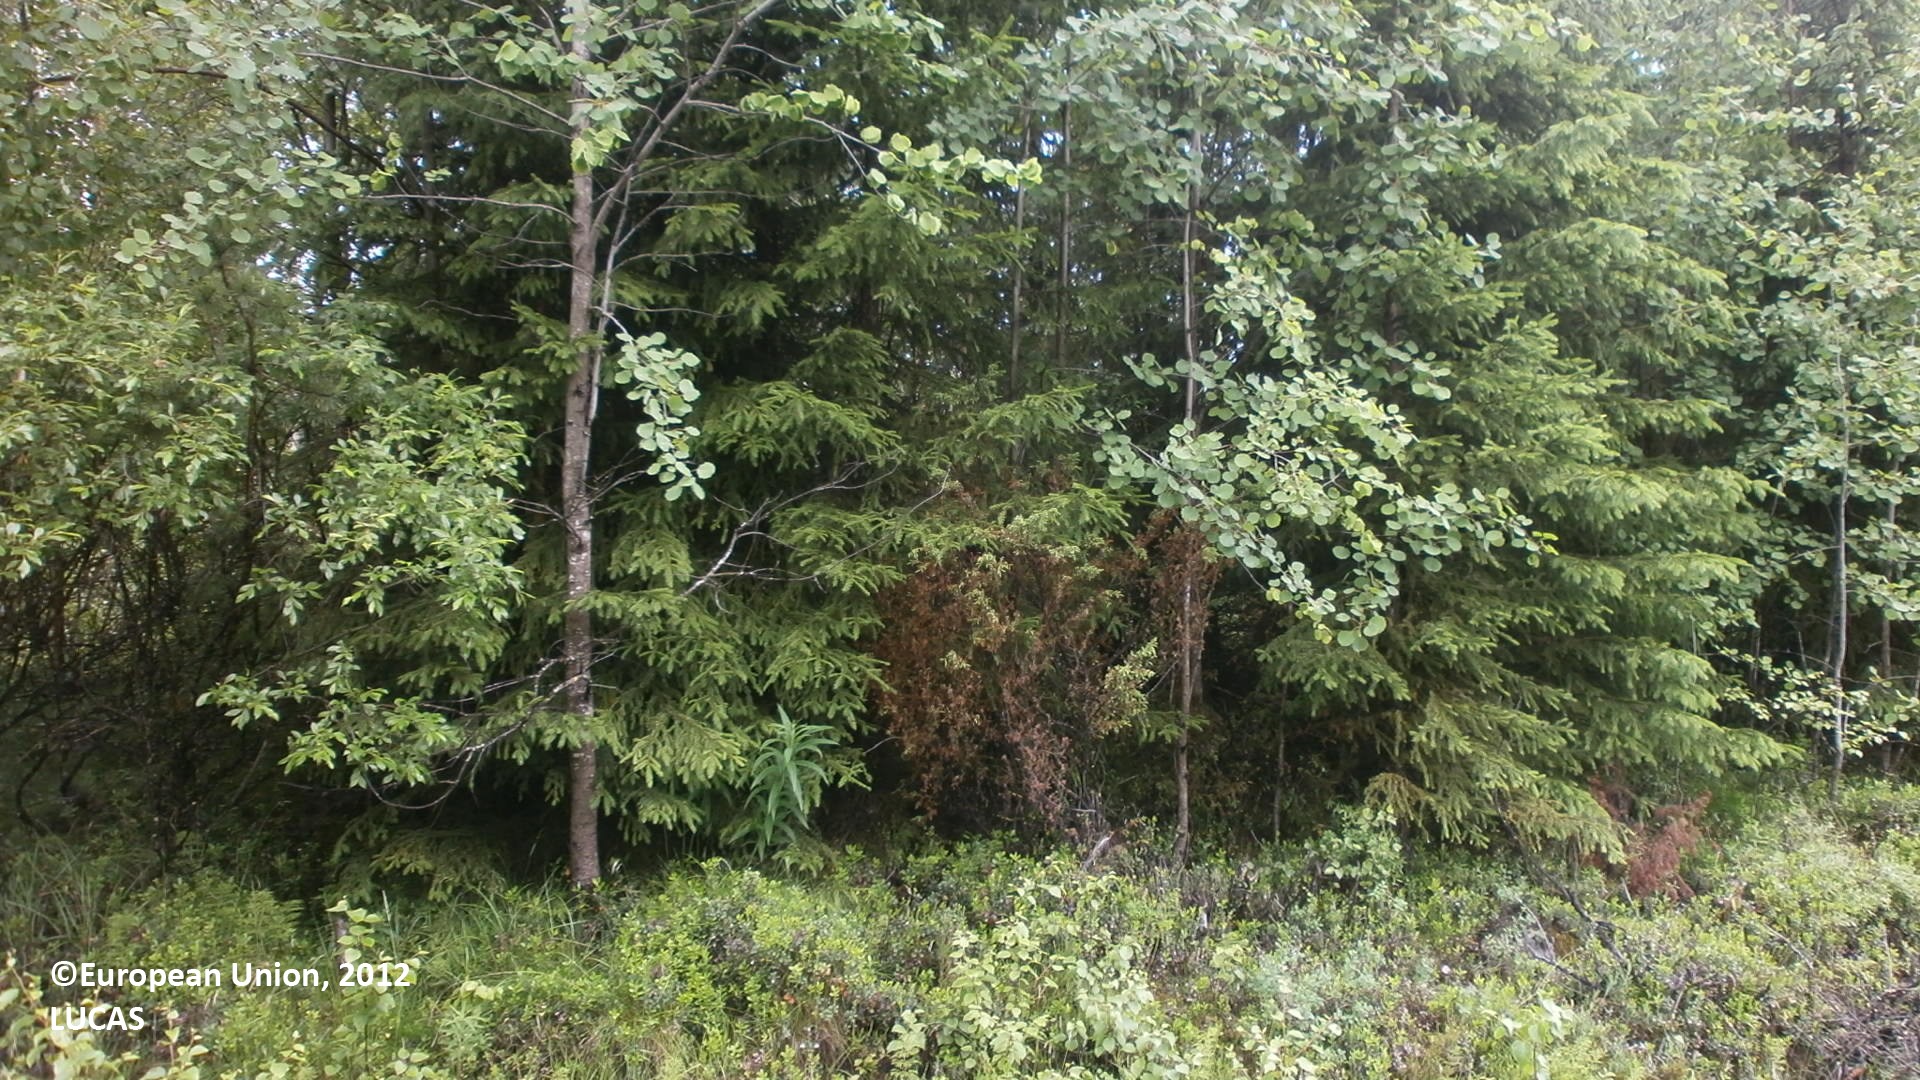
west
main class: Artificial land
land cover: Non built-up linear features
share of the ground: 50 - 75 %
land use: Railway transport
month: July
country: FI
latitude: 64.3648
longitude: 24.9751
